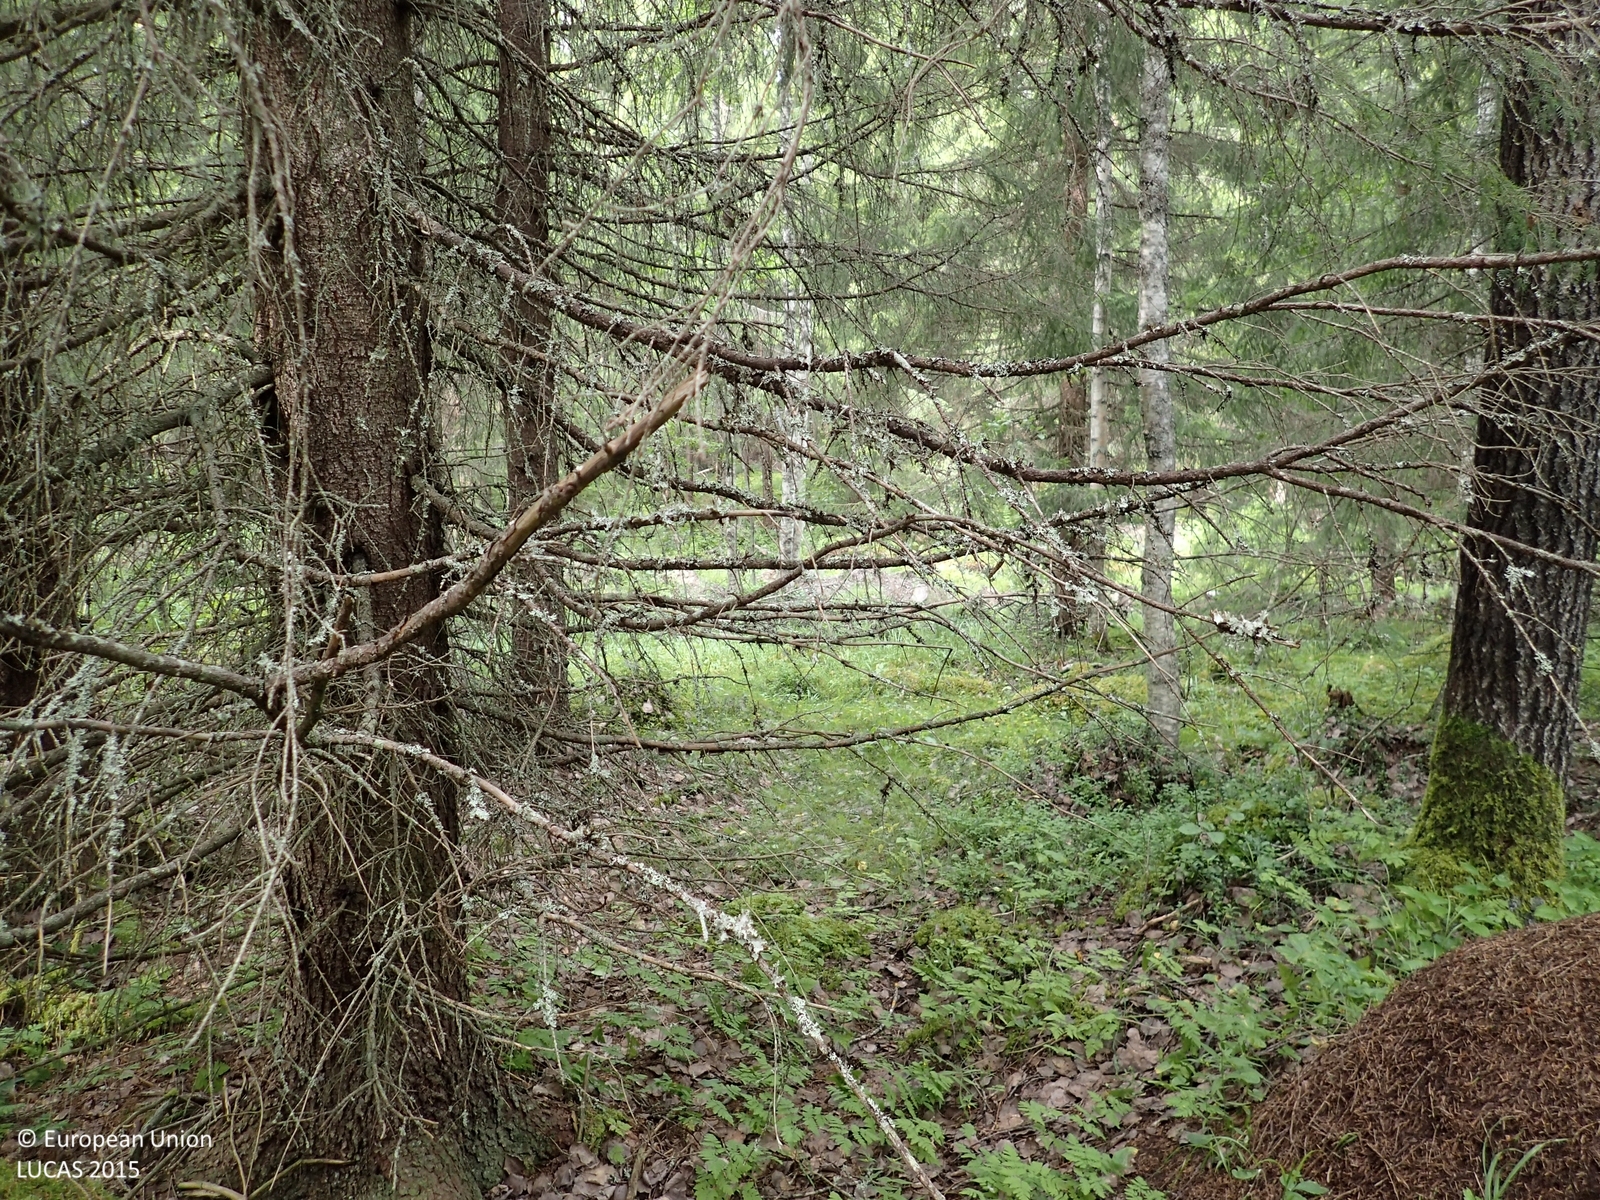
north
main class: Woodland
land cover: Spruce dominated mixed woodland
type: boreal forest
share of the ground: > 75 %
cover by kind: coniferous forest trees 60 %, broadleaved forest trees 20 %, herbaceous plants 10 %, shrubs 5 %, lichens and mosses 5 %
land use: Forestry
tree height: > 5 m
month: August
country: FI
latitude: 62.8314
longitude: 21.9221
